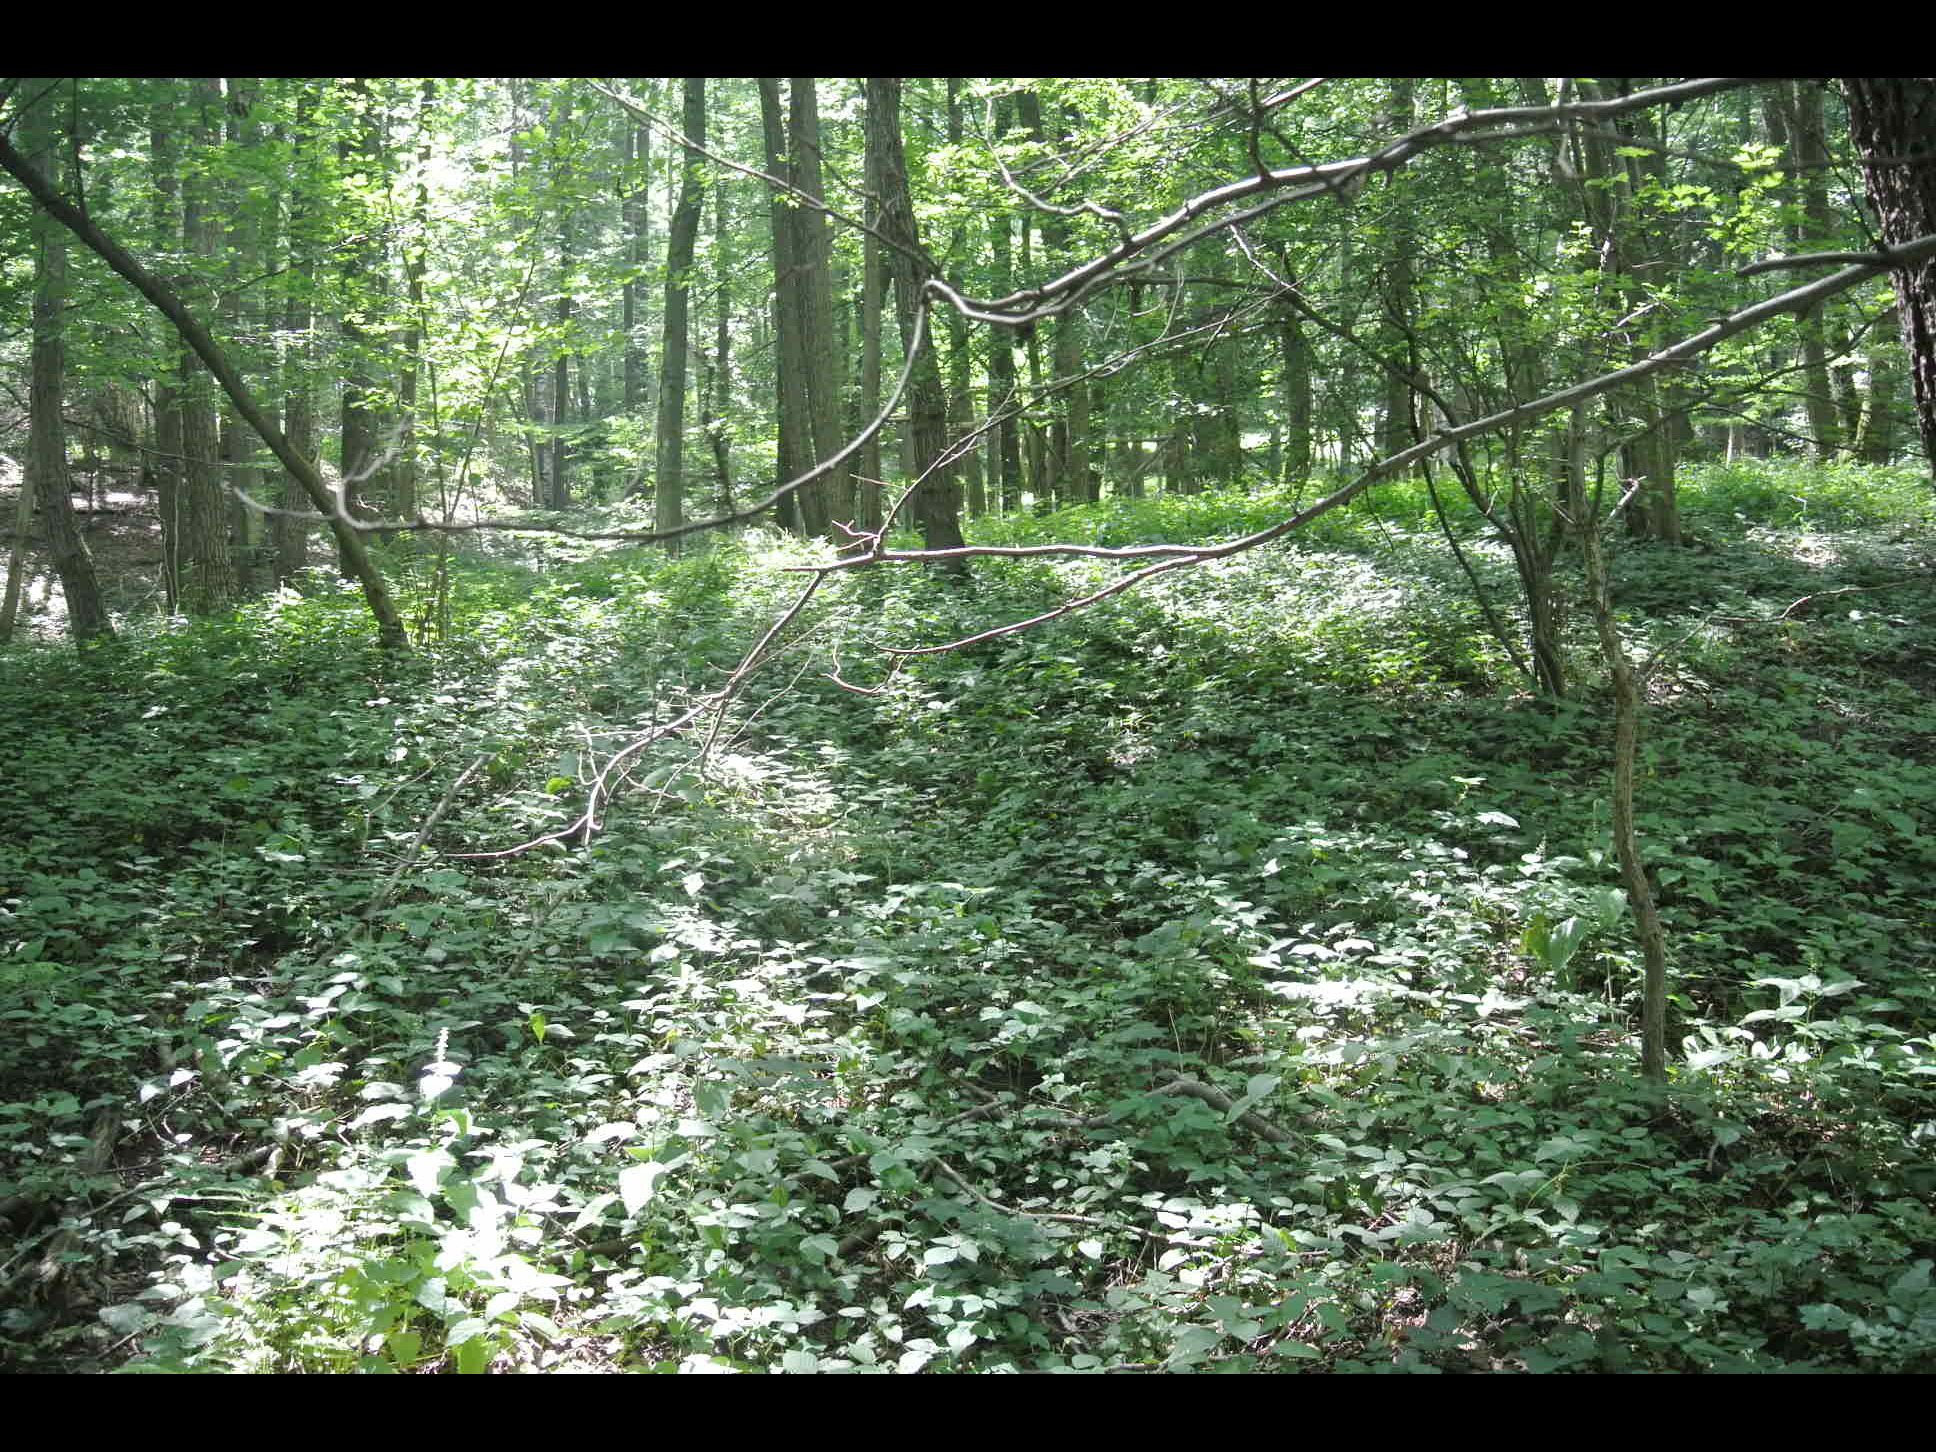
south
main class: Woodland
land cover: Broadleaved woodland
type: beech forest
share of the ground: > 75 %
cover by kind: broadleaved forest trees 90 %, herbaceous plants 10 %
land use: Forestry
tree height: > 5 m
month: July
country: AT
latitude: 48.0454
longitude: 15.5960
